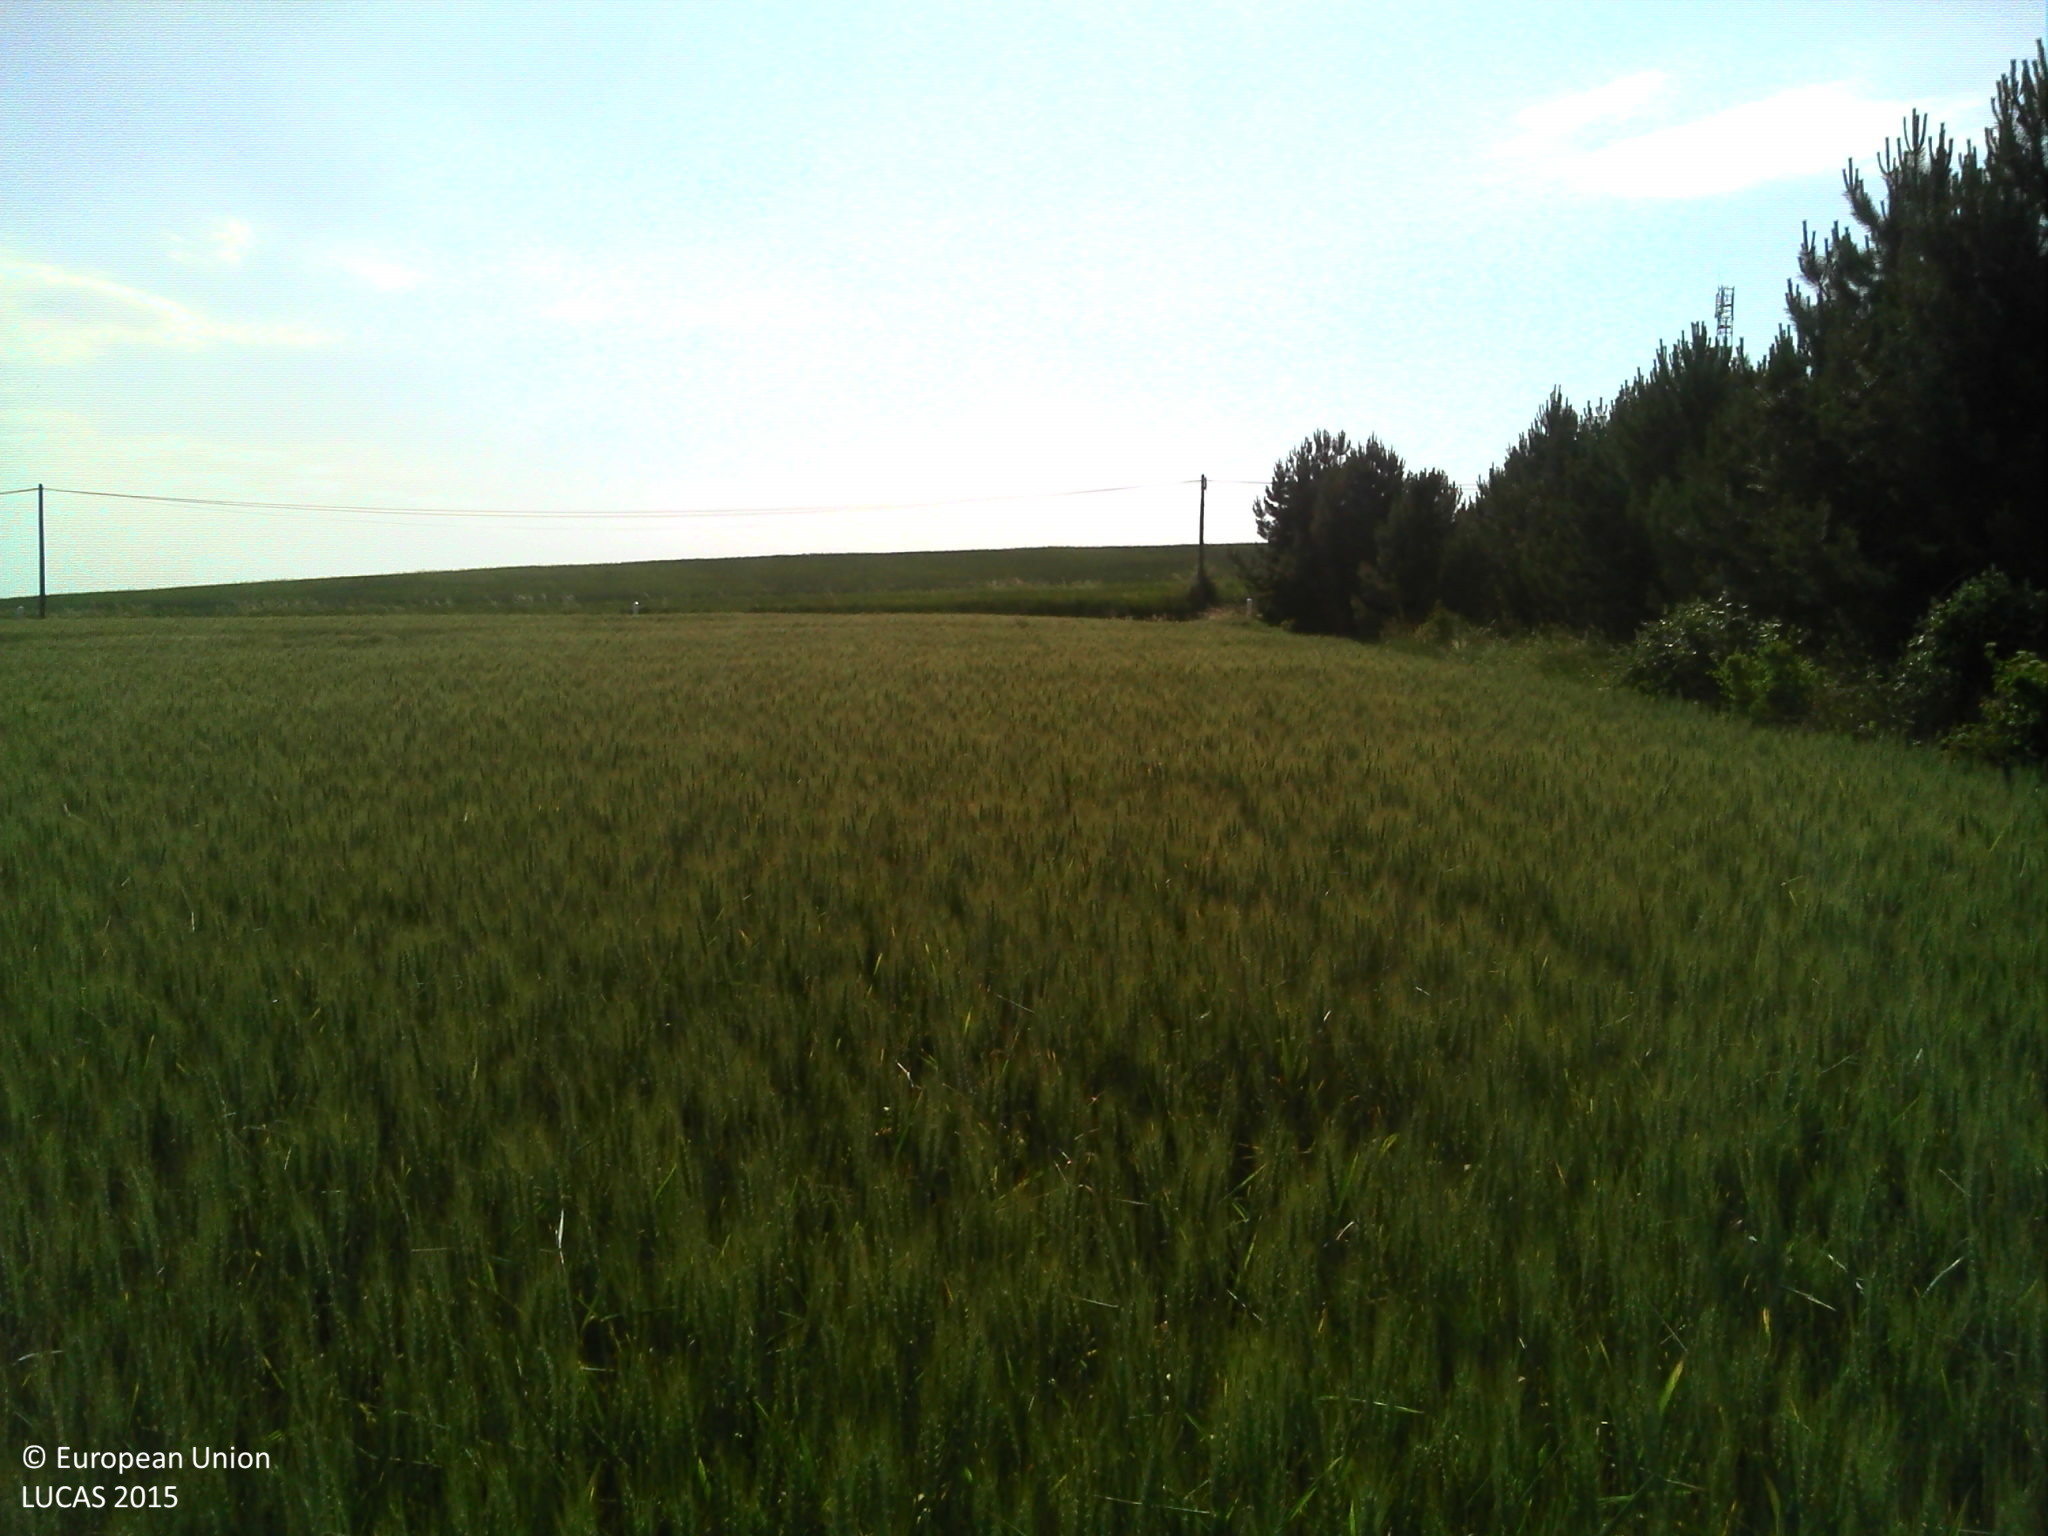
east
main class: Cropland
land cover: Common wheat
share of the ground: > 75 %
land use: Agriculture (excluding fallow land and kitchen gardens)
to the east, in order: Common wheat; Electric lines; Common wheat; Grass margins; Ditches and canals; Grass margins; Paved roads, cycling and walking lanes; Grass margins; Ditches and canals; Grass margins; Electric lines; Common wheat
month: June
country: FR
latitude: 47.6015
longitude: 3.8655
